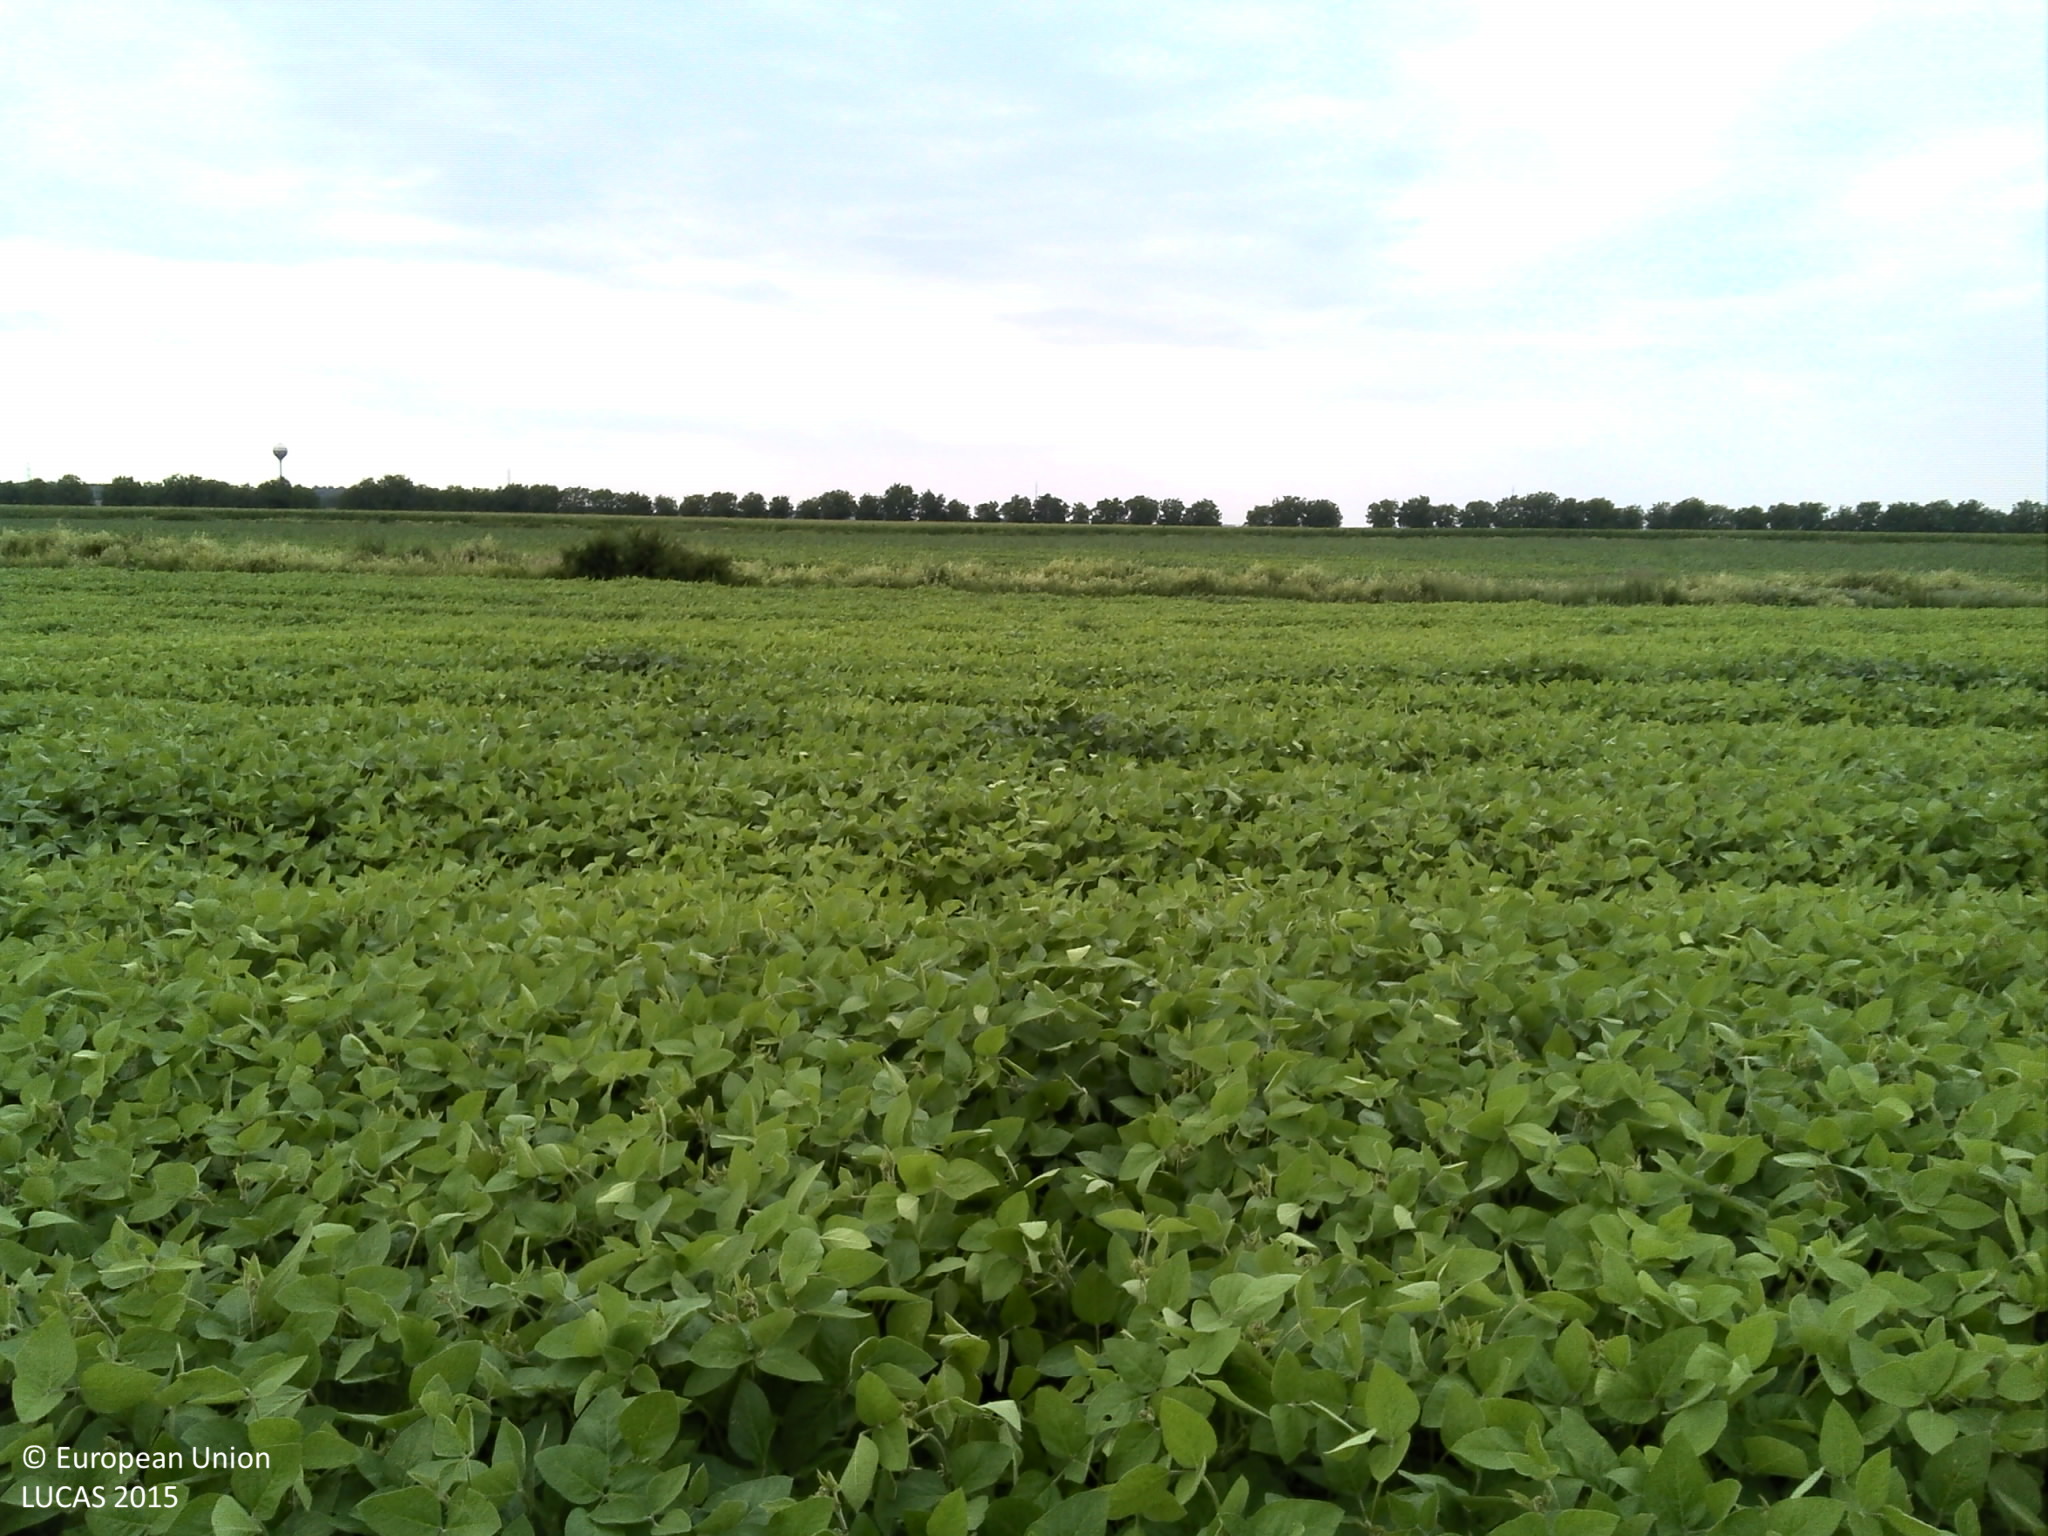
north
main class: Cropland
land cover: Soya
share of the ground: > 75 %
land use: Agriculture (excluding fallow land and kitchen gardens)
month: June
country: HR
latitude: 45.4860
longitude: 18.5147
